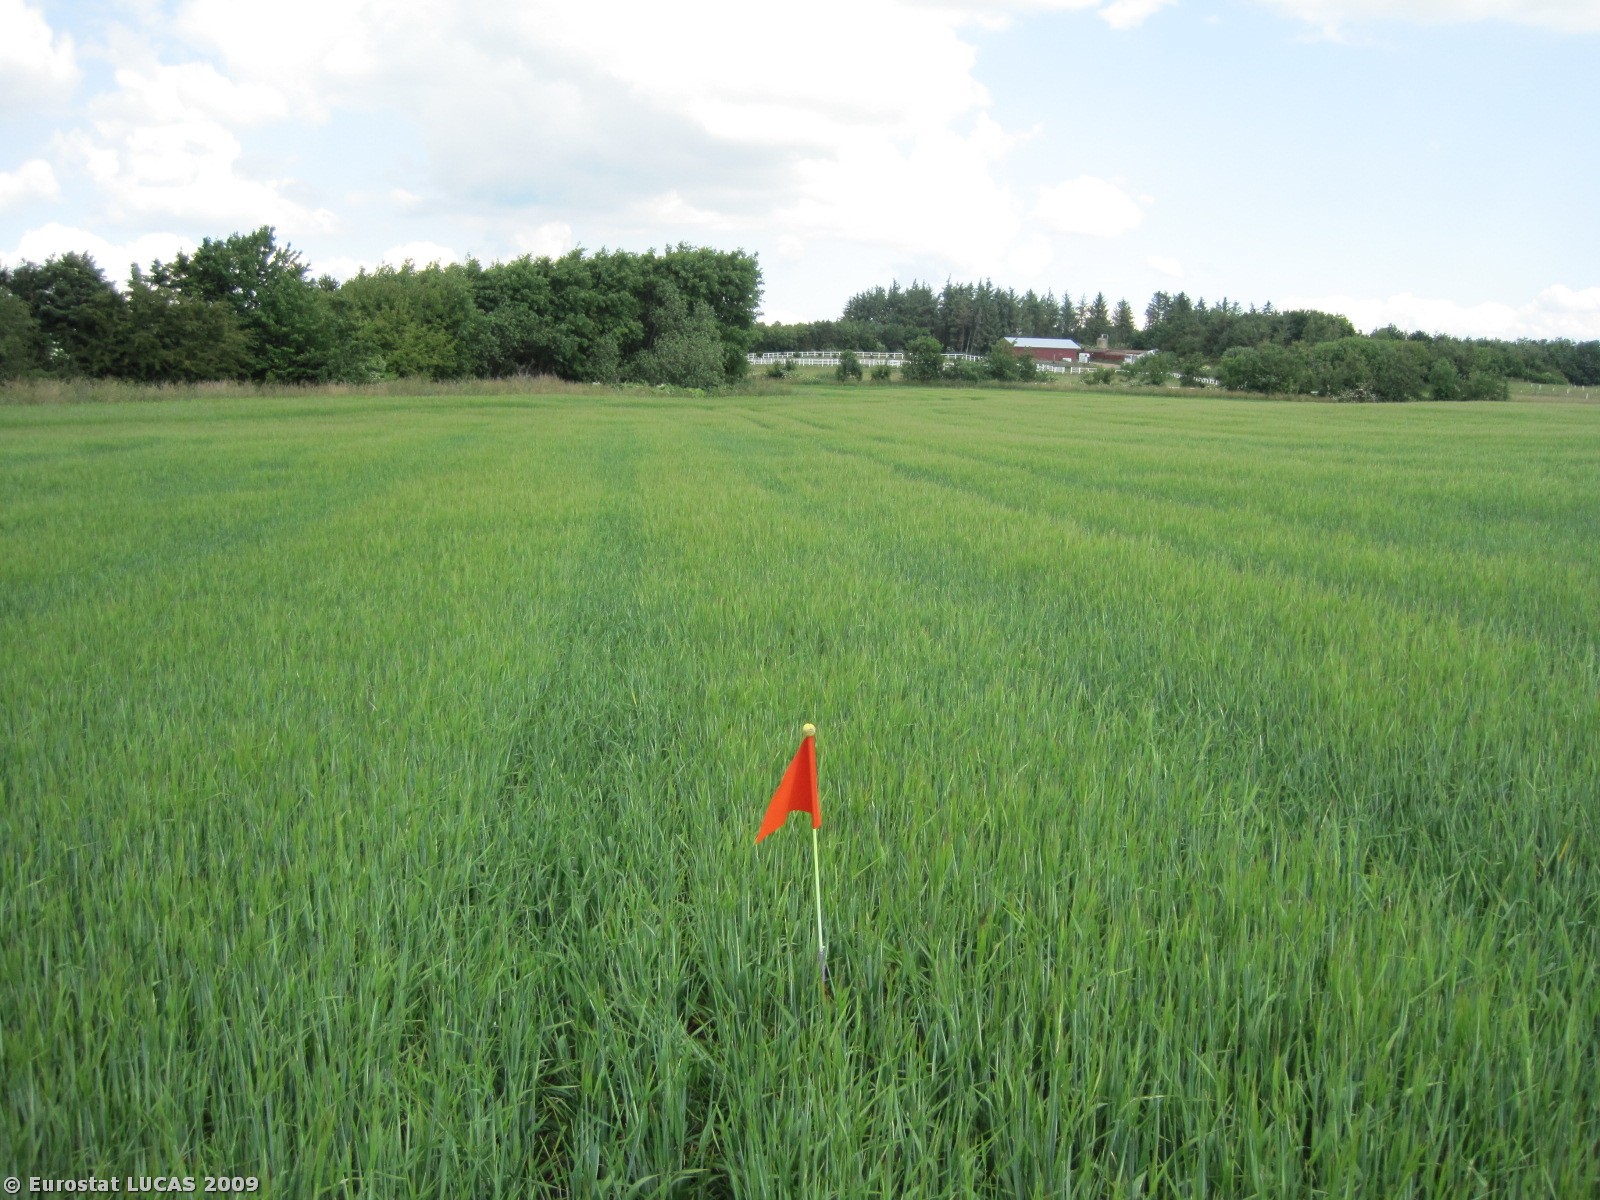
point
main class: Cropland
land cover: Barley
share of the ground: > 75 %
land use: Agriculture (excluding fallow land and kitchen gardens)
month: June
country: DK
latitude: 56.6511
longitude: 8.9738
